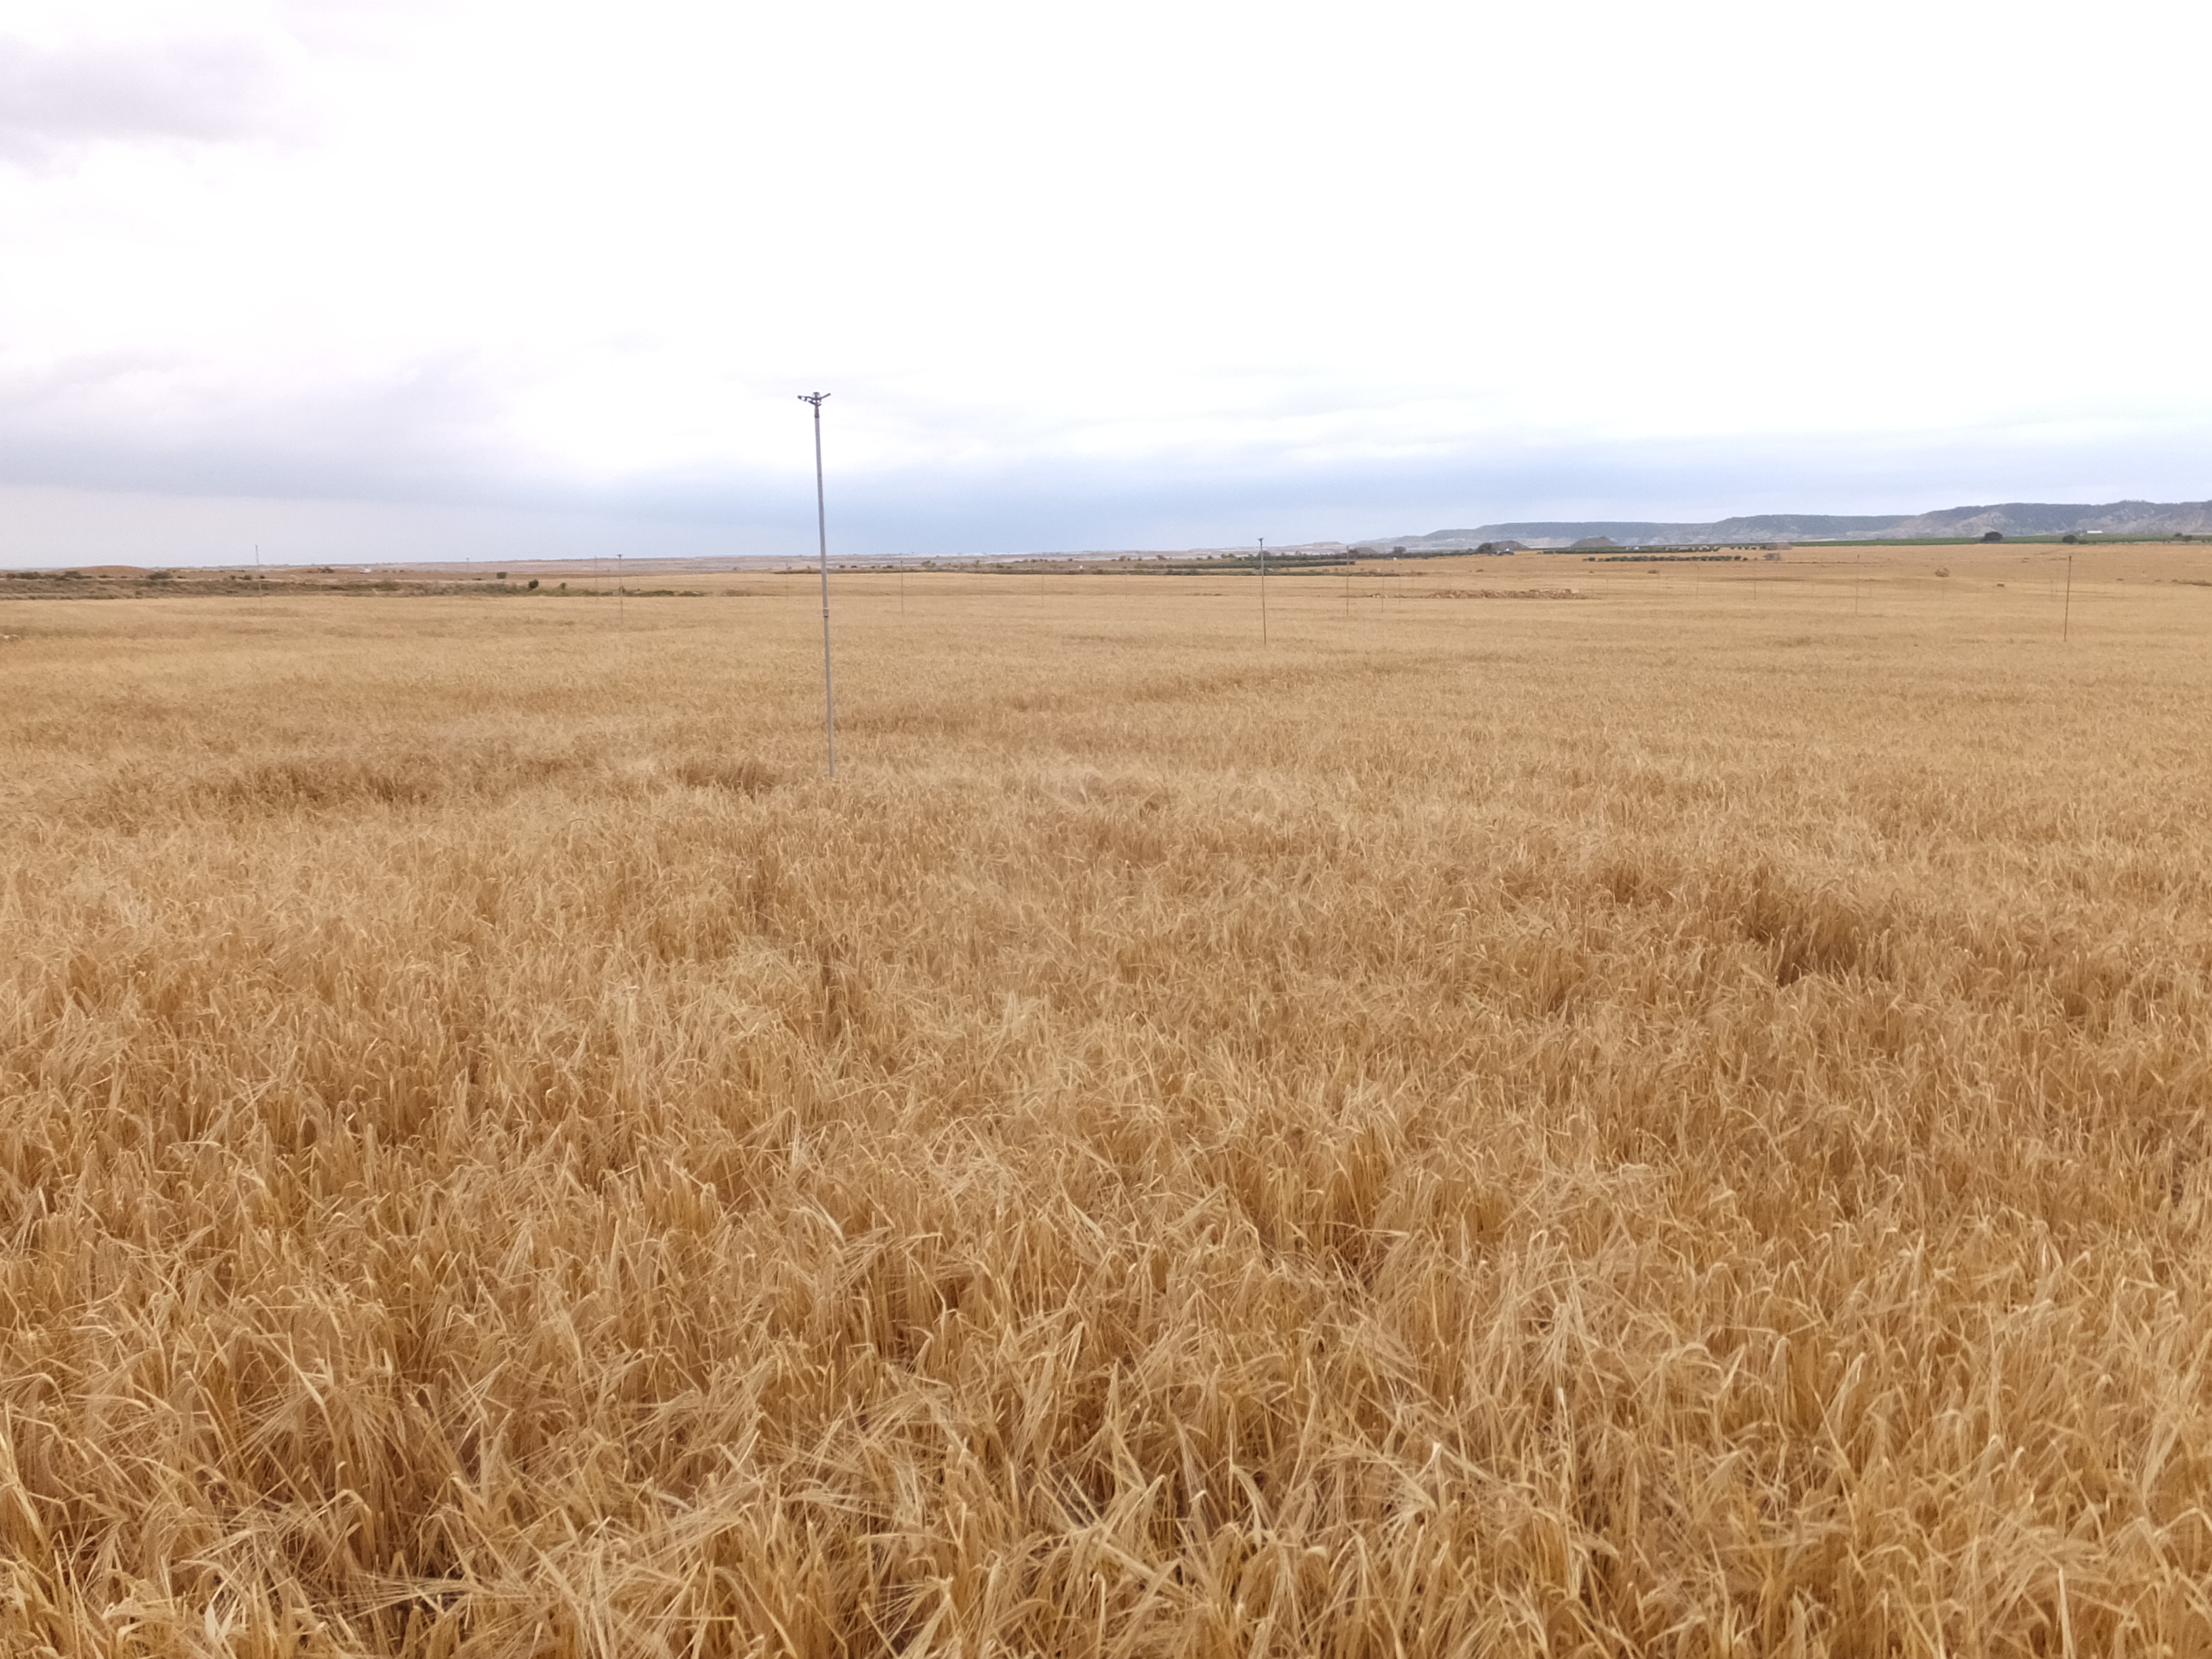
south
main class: Cropland
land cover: Barley
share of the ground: > 75 %
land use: Agriculture (excluding fallow land and kitchen gardens)
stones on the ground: < 10 %
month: June
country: ES
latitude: 41.6541
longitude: 0.0538
